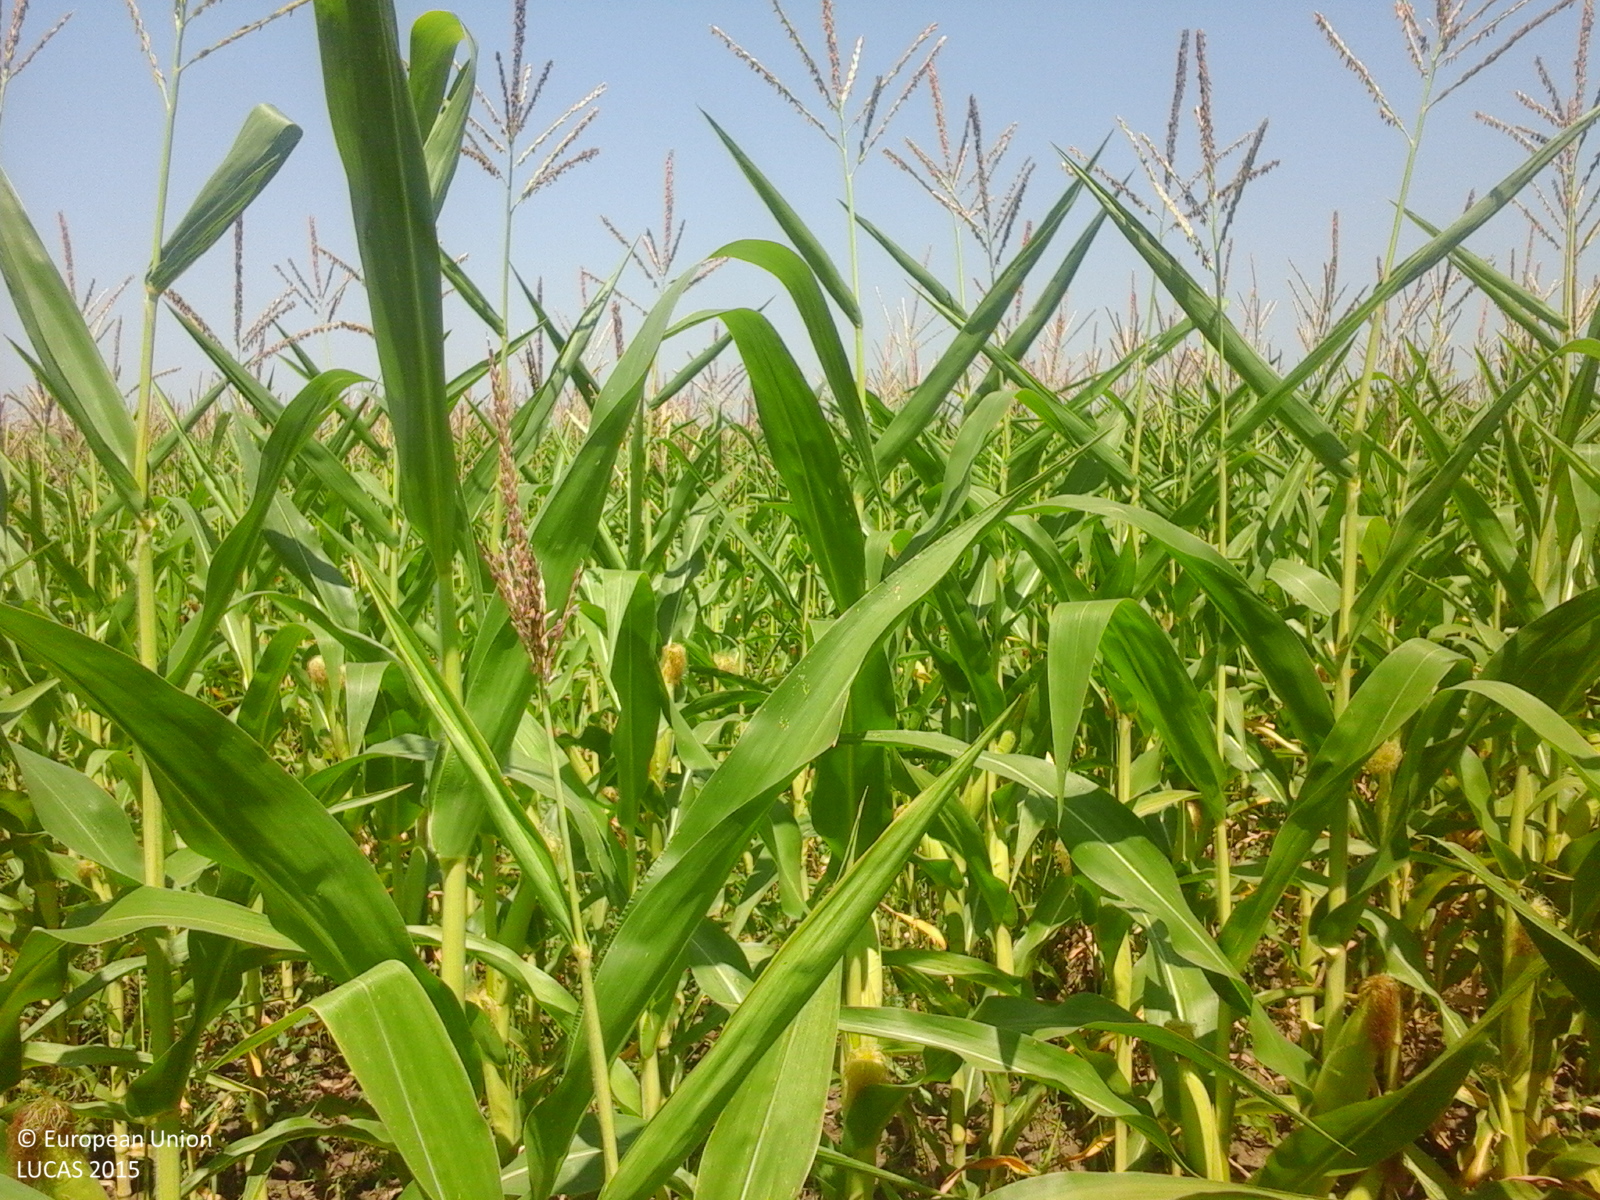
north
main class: Cropland
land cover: Maize
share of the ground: > 75 %
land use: Agriculture (excluding fallow land and kitchen gardens)
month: July
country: RO
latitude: 44.7548
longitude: 26.7876
